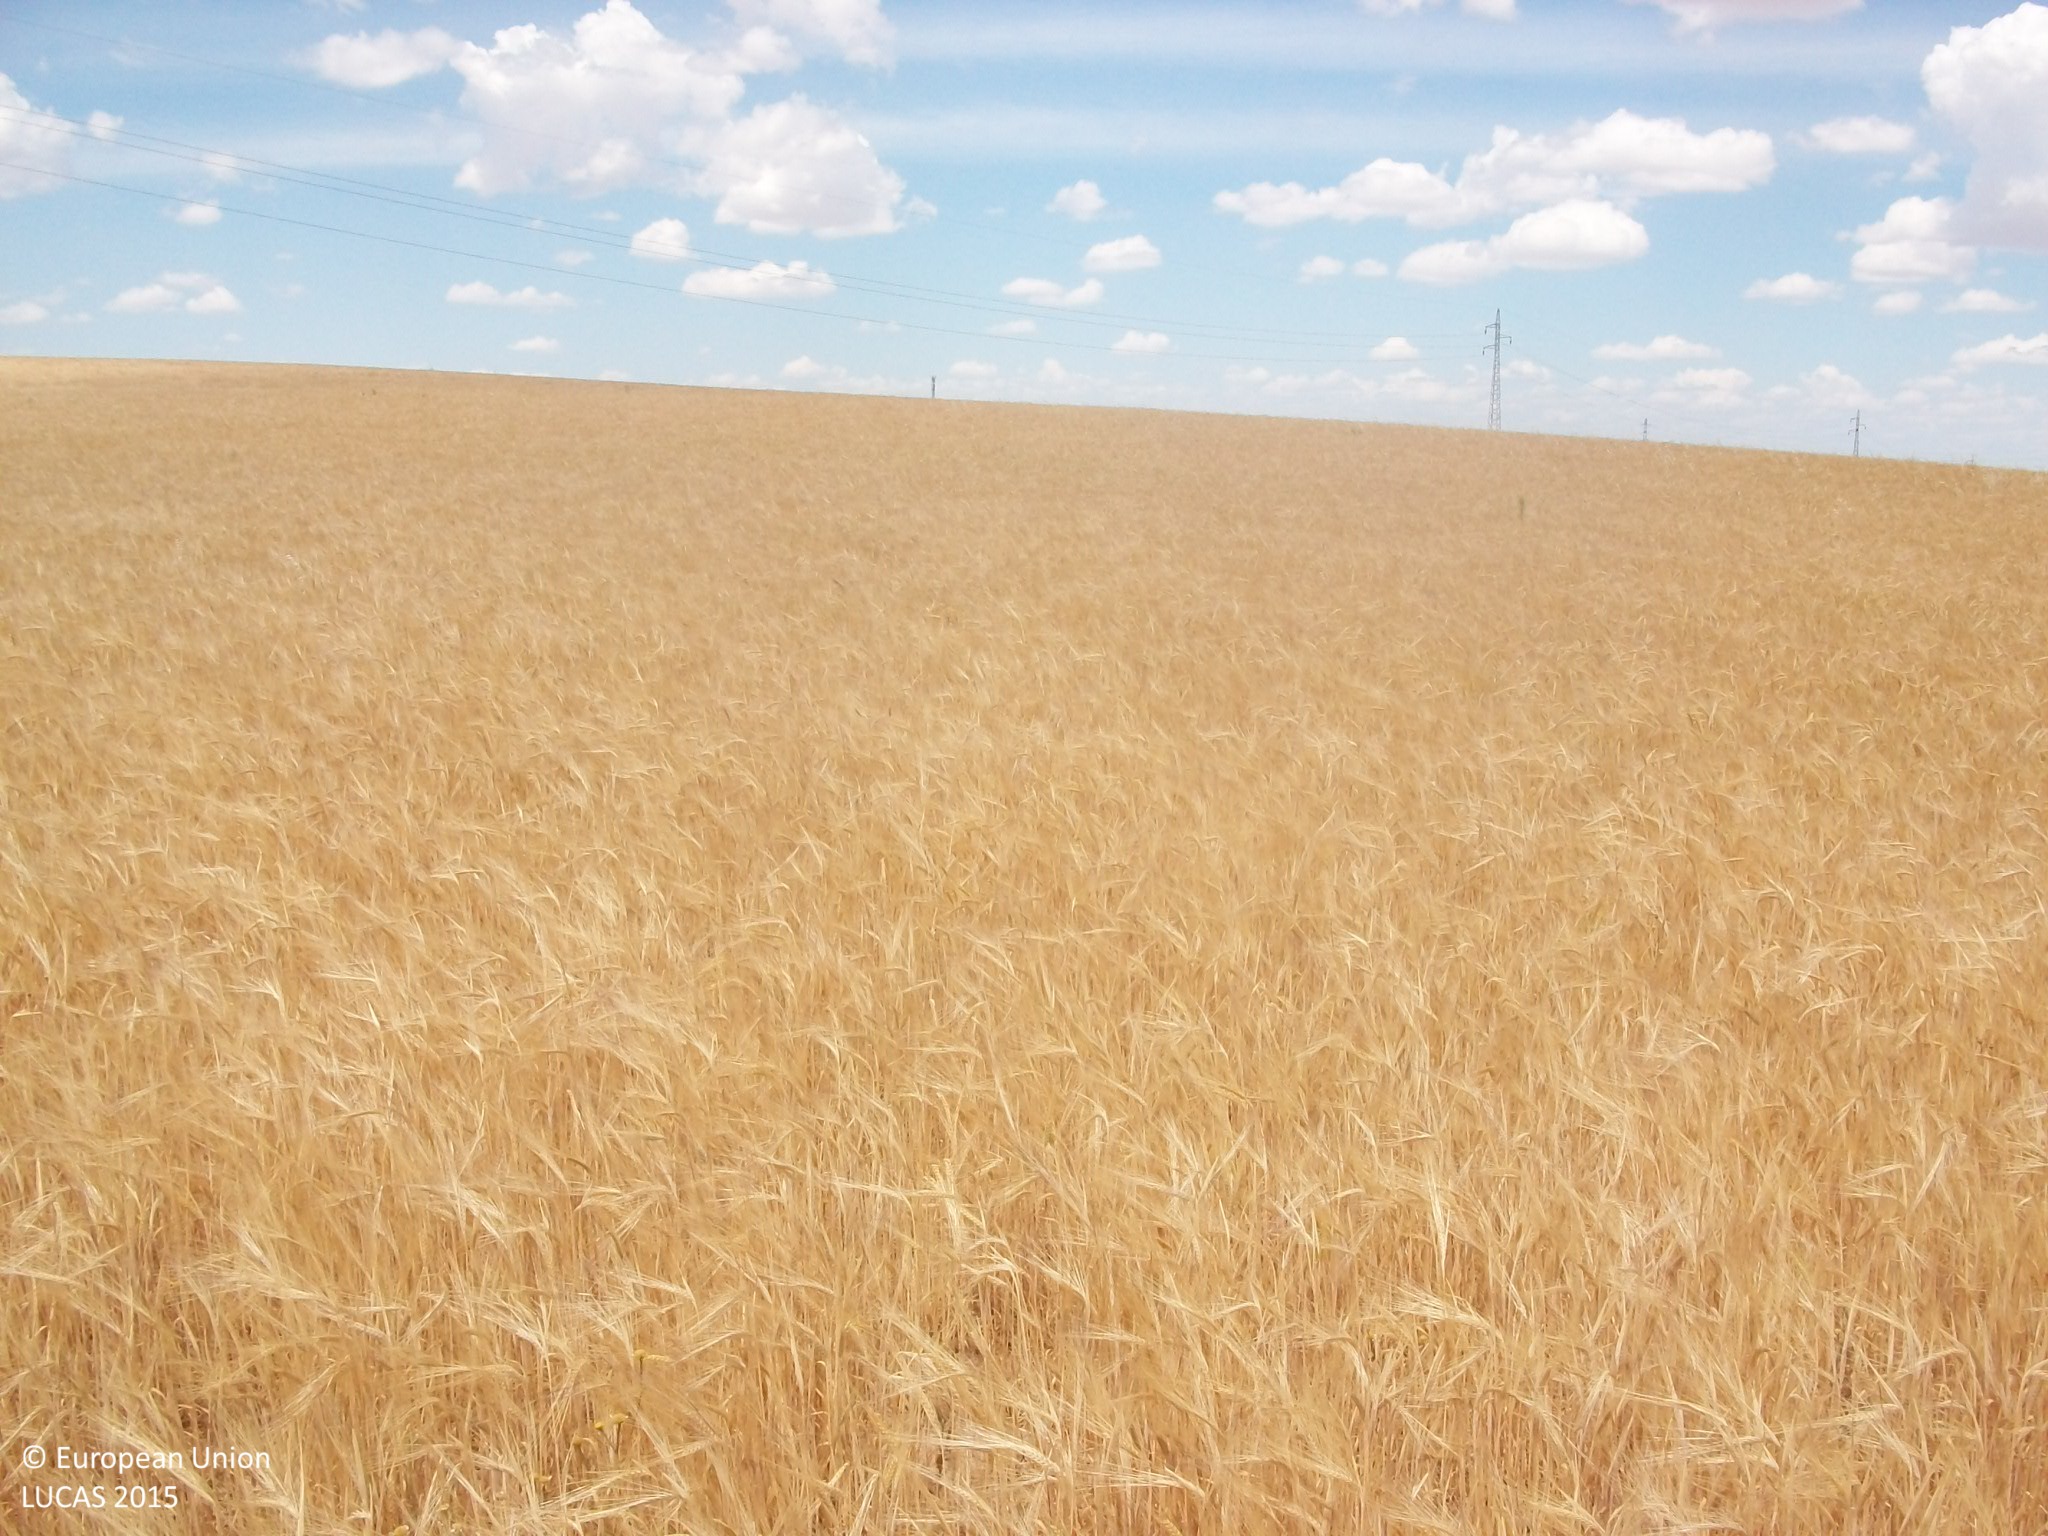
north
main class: Cropland
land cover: Barley
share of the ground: > 75 %
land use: Agriculture (excluding fallow land and kitchen gardens)
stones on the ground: 10 - 25 %
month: May
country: ES
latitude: 40.0750
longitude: -3.6701
